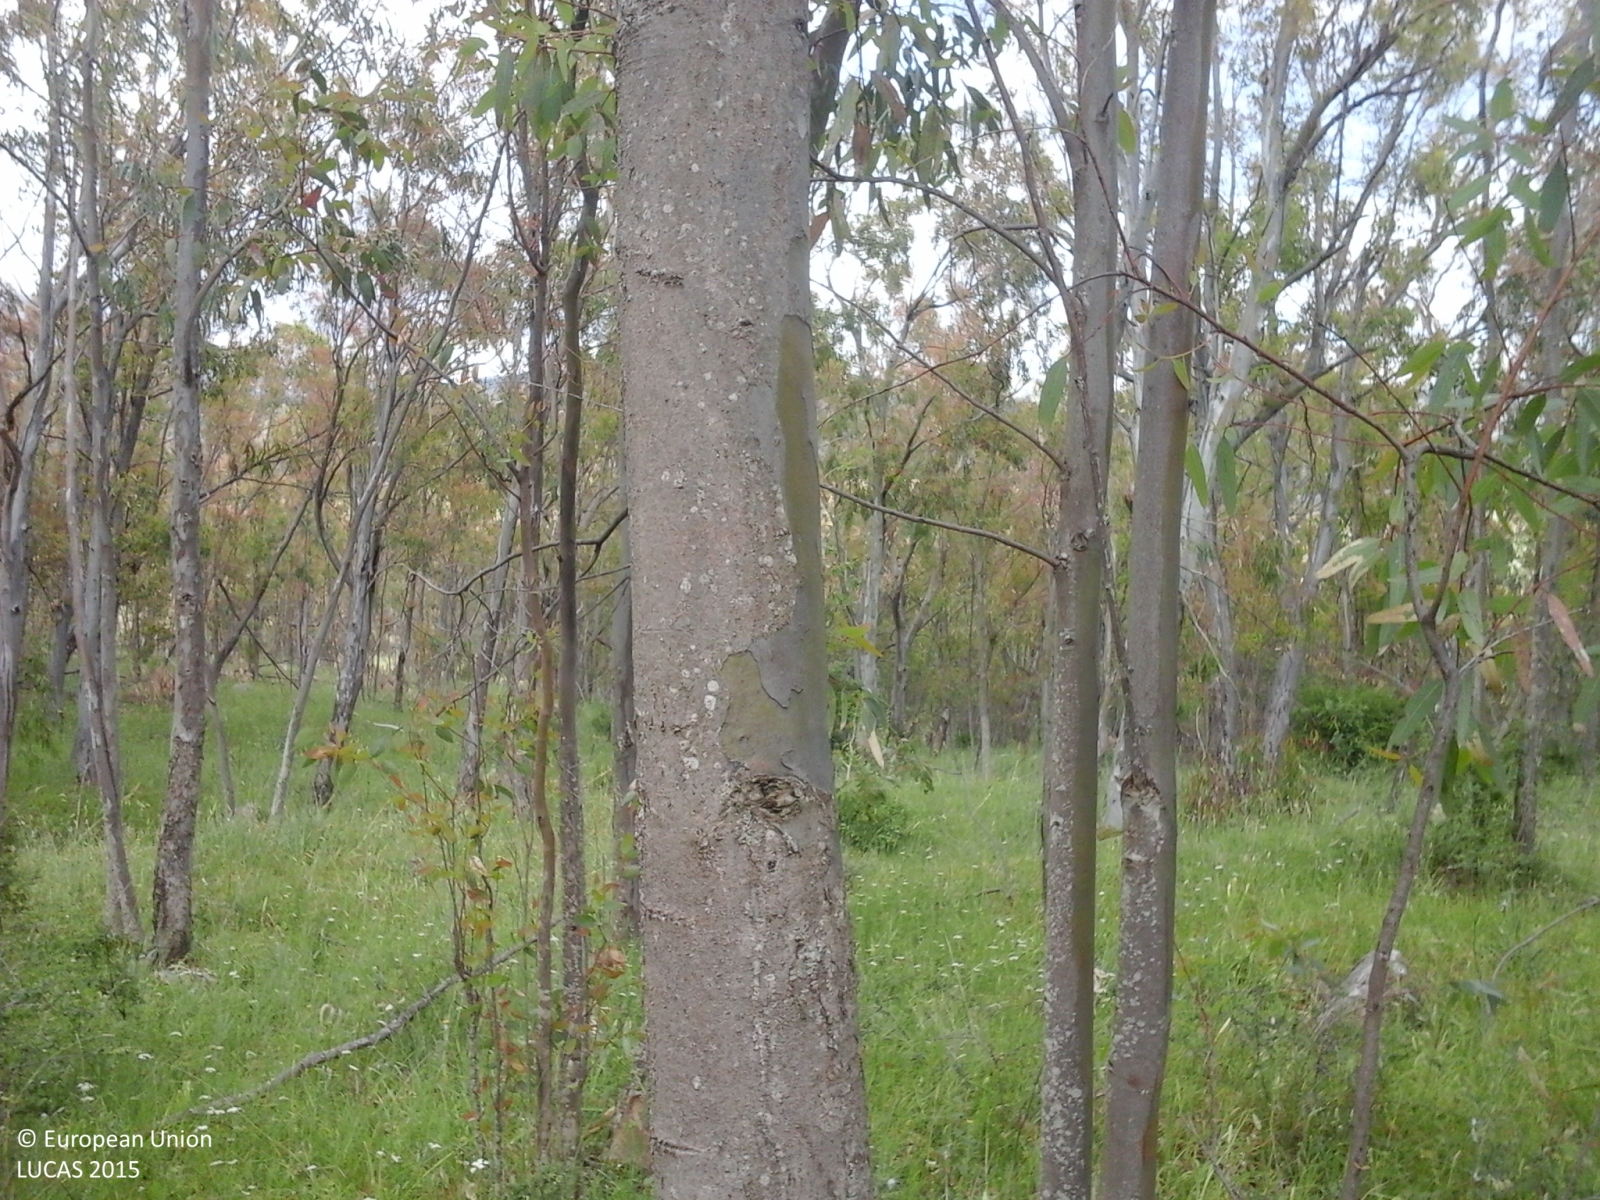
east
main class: Woodland
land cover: Broadleaved woodland
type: broadleaved evergreen forest
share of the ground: > 75 %
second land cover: Grassland without tree/shrub cover
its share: > 75 %
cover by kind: broadleaved forest trees 80 %, herbaceous plants 10 %, shrubs 5 %, consolidated bare surface 5 %
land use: Forestry
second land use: Agriculture (excluding fallow land and kitchen gardens)
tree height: > 5 m
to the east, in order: Broadleaved woodland; Grassland without tree/shrub cover; Ditches and canals; Broadleaved woodland; Ditches and canals; Broadleaved woodland
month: May
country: IT
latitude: 37.8259
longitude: 14.4338
